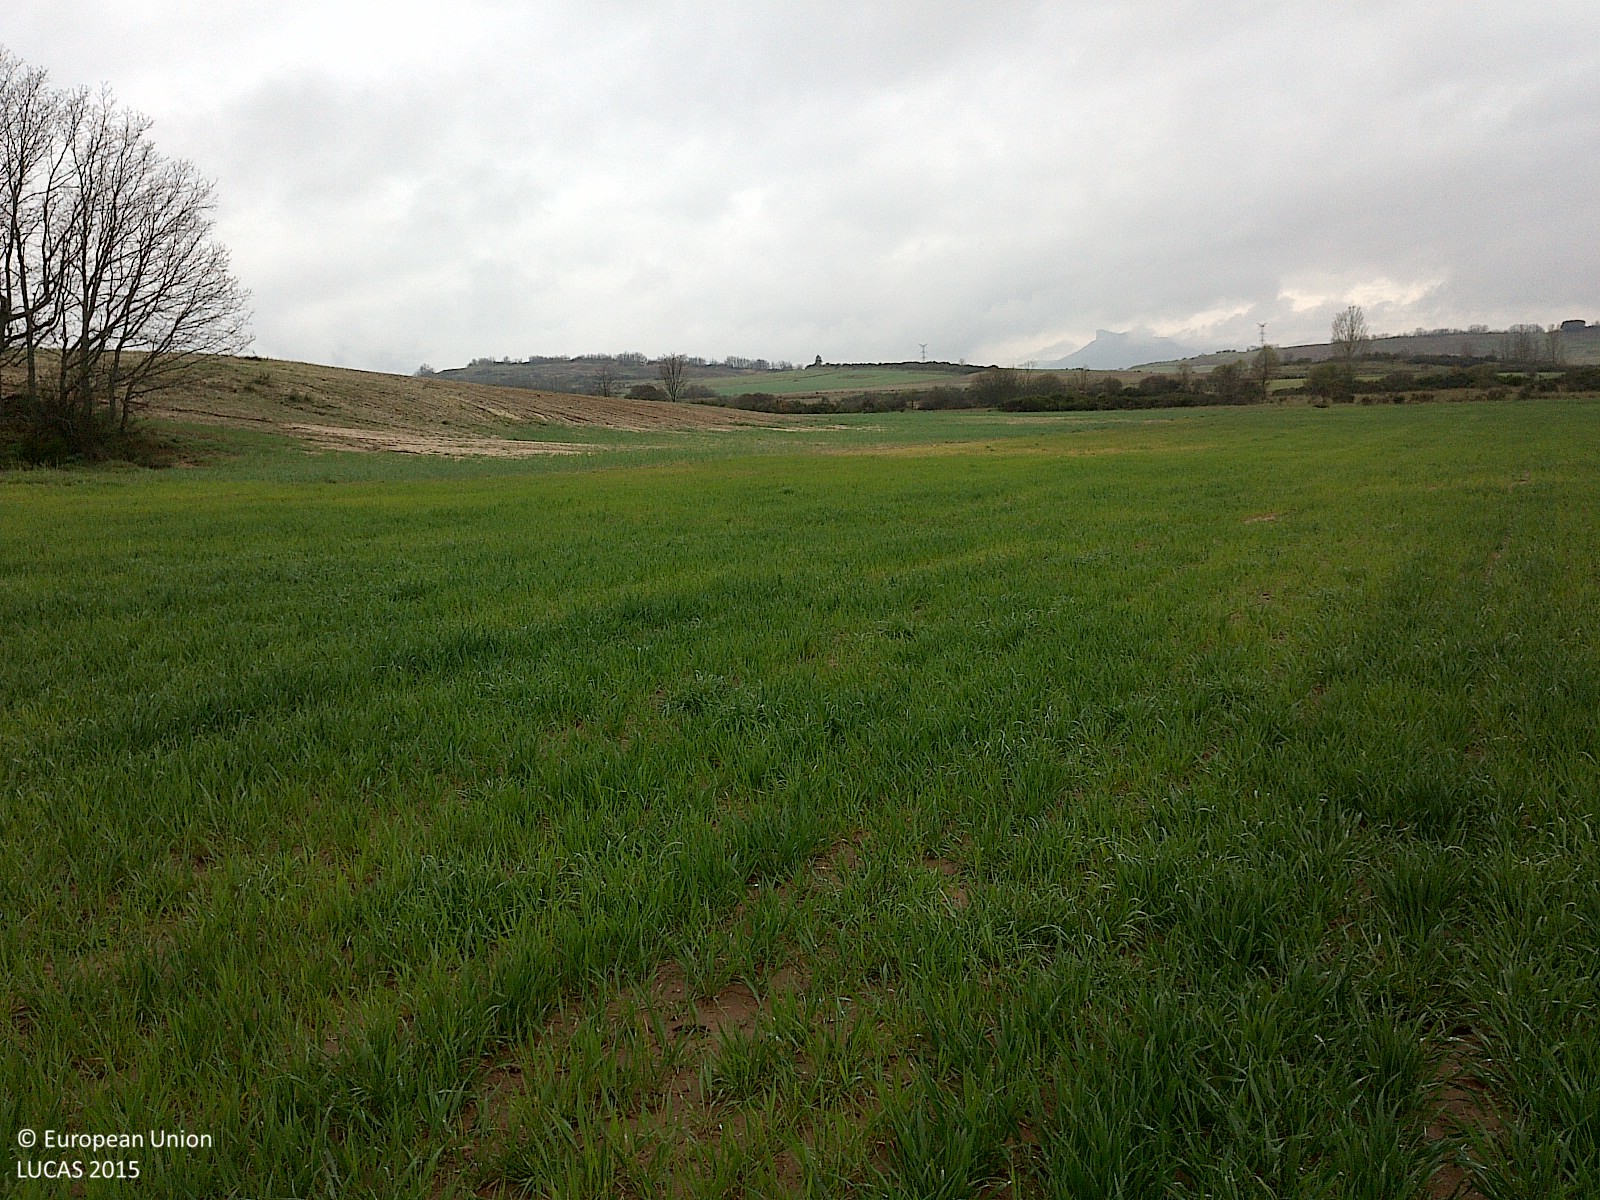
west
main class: Cropland
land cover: Common wheat
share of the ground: > 75 %
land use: Agriculture (excluding fallow land and kitchen gardens)
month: April
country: ES
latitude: 41.9960
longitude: -3.2694
